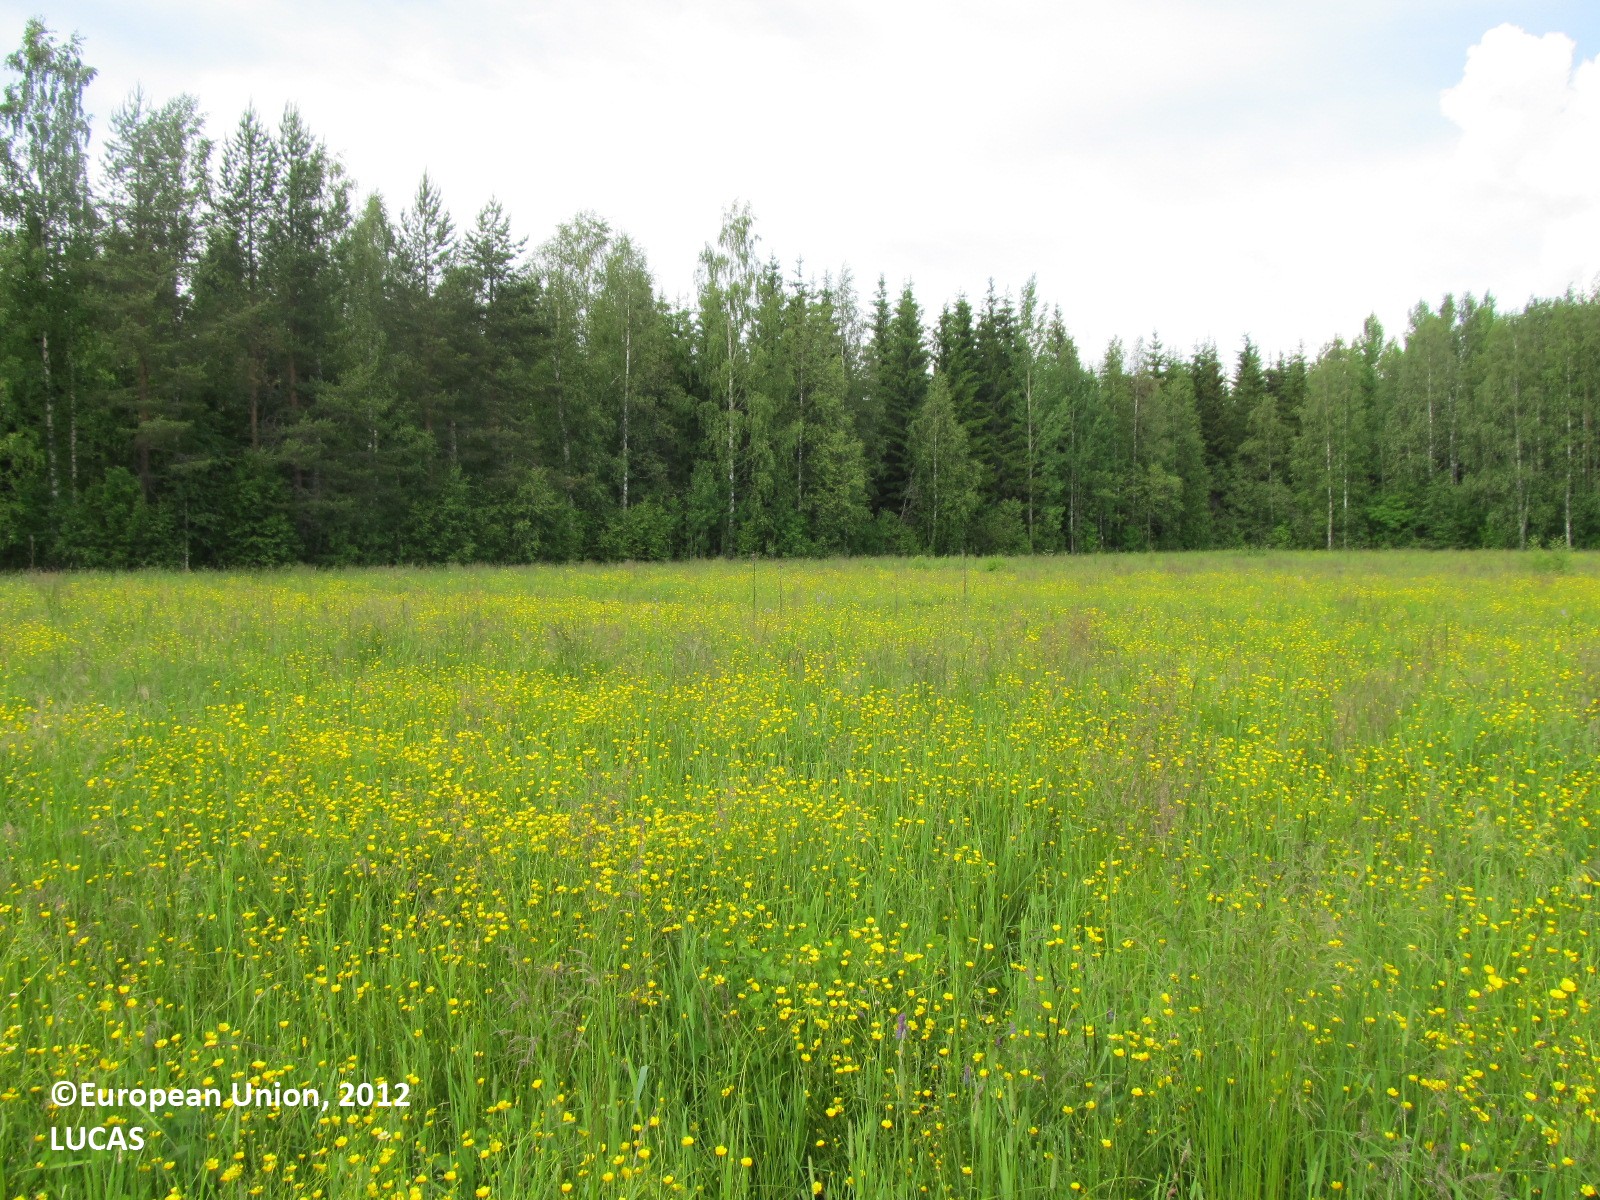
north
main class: Grassland
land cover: Grassland without tree/shrub cover
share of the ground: > 75 %
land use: Agriculture (excluding fallow land and kitchen gardens)
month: June
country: FI
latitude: 62.8092
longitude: 29.2329
